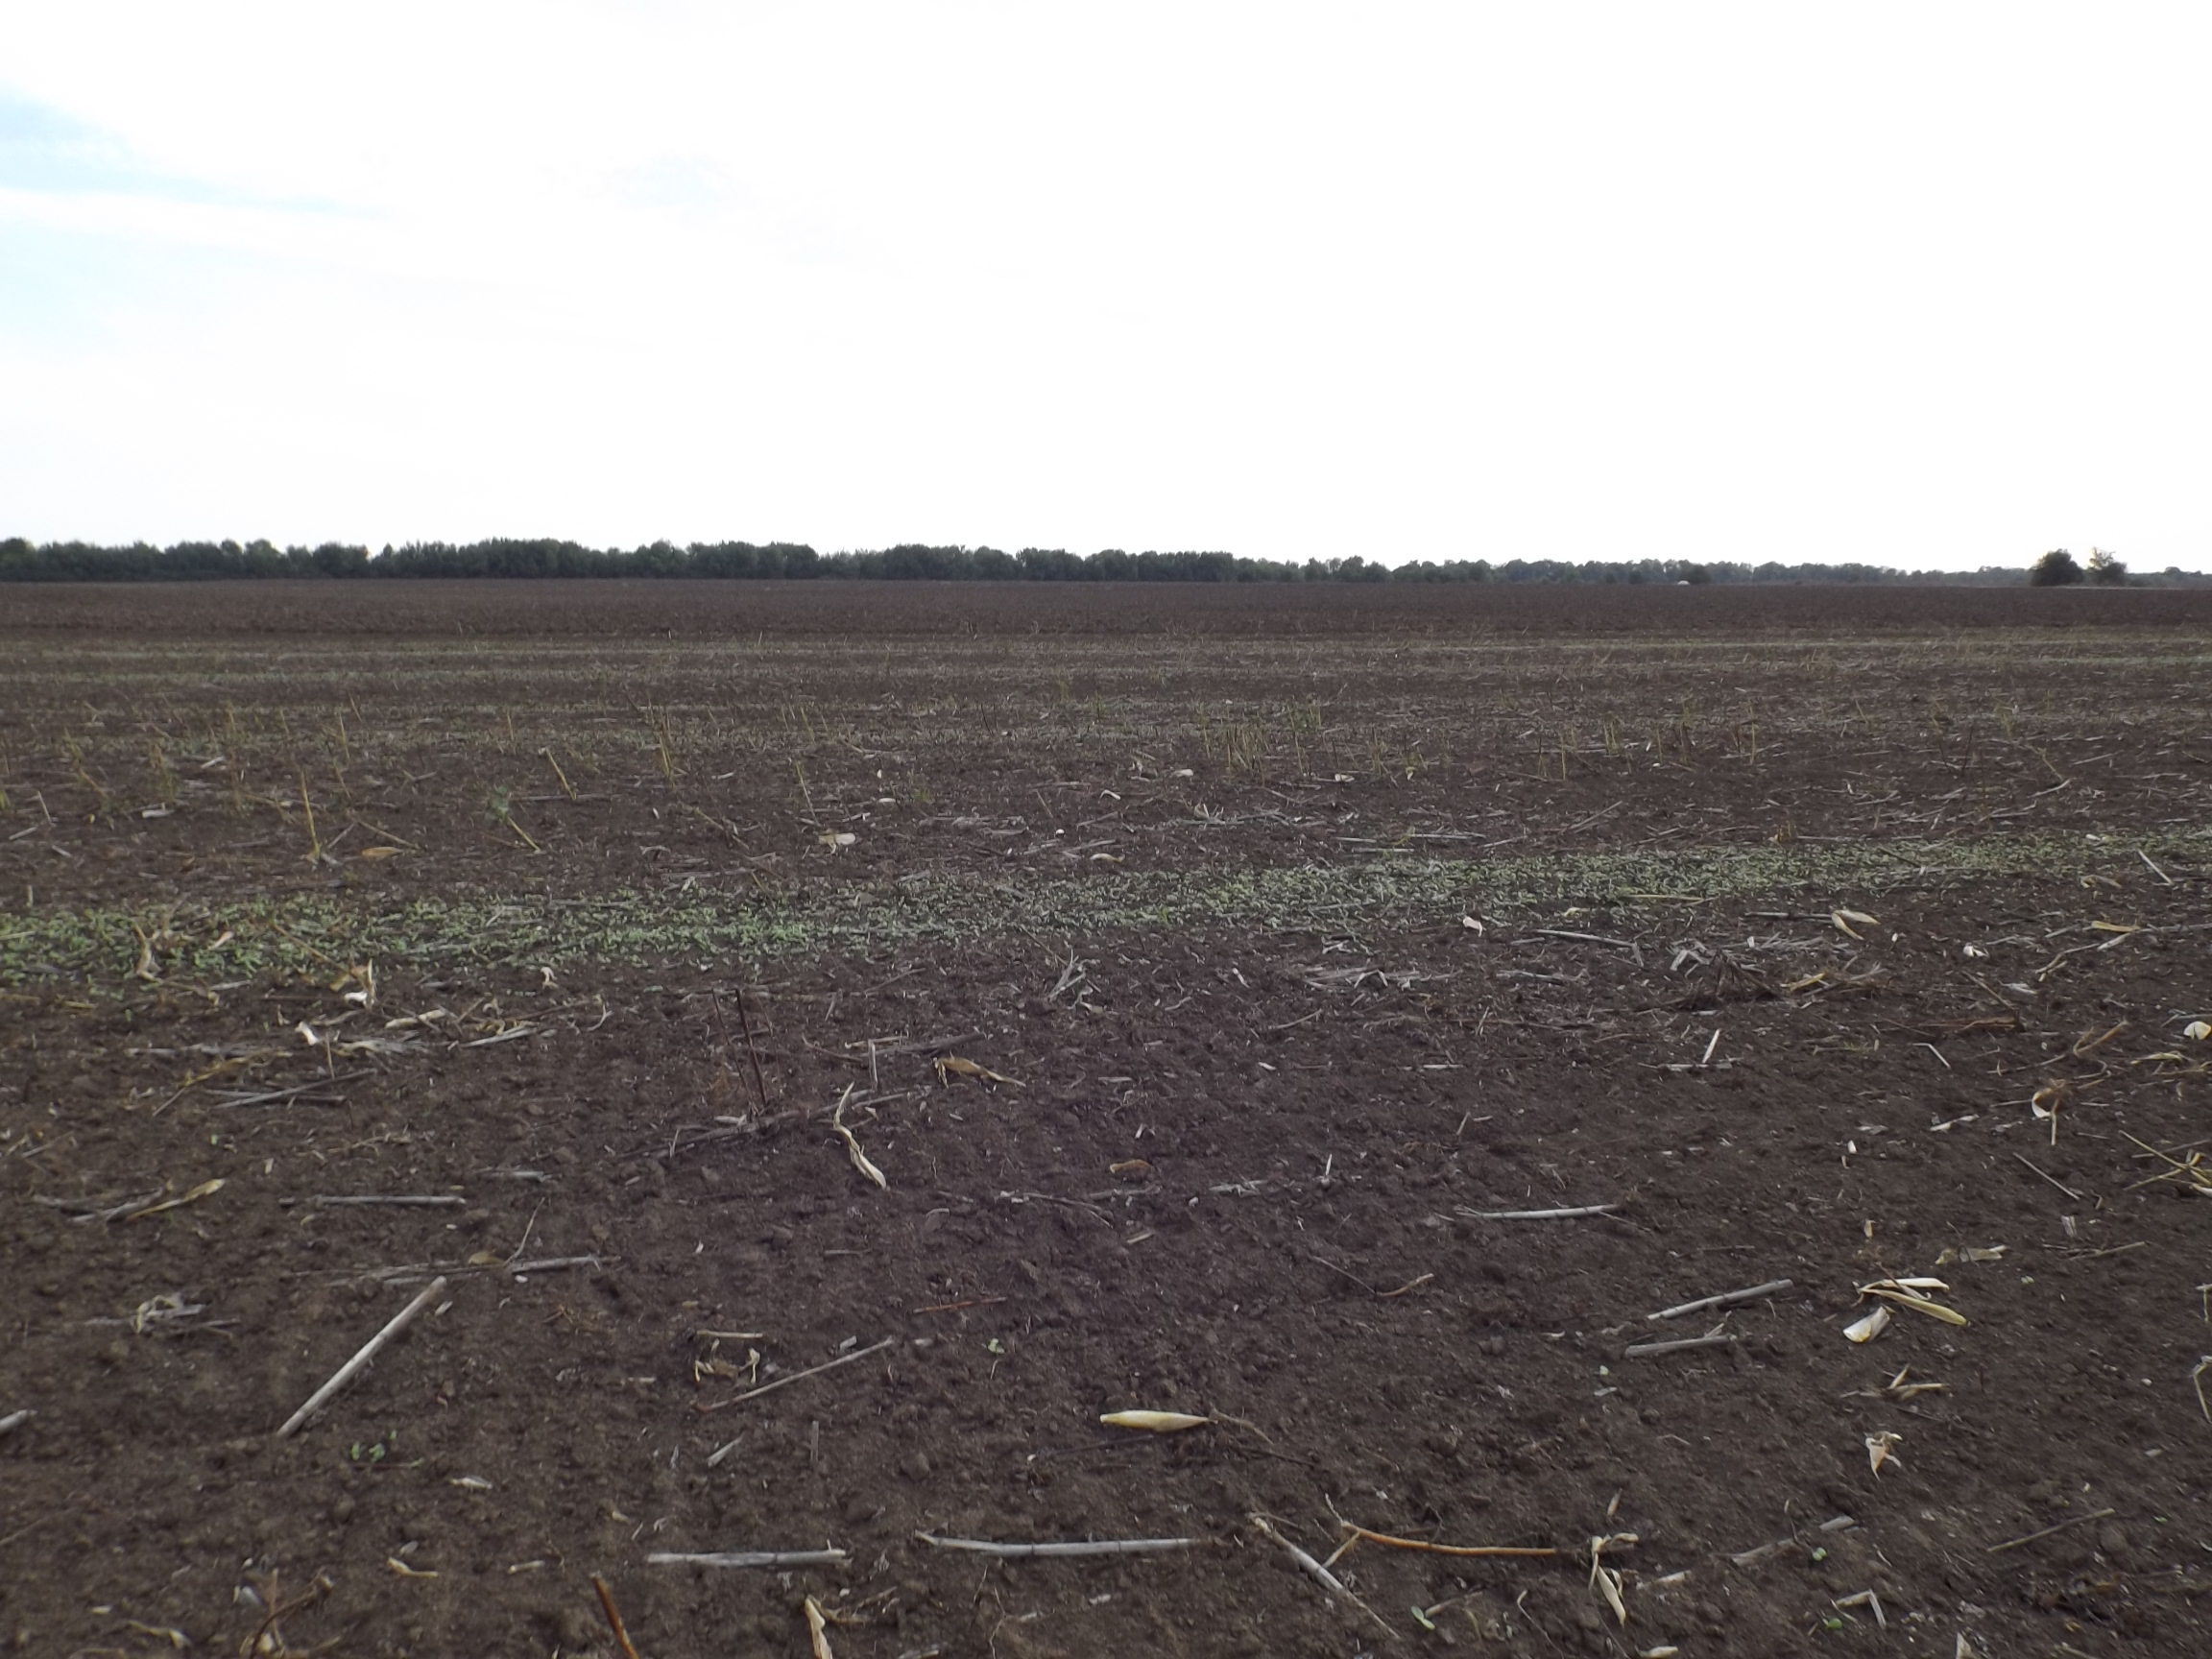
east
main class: Cropland
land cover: Sunflower
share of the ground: < 10 %
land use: Agriculture (excluding fallow land and kitchen gardens)
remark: Harvested field
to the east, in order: Sunflower; Maize; Other bare soil
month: October
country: BG
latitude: 43.9491
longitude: 26.8785
